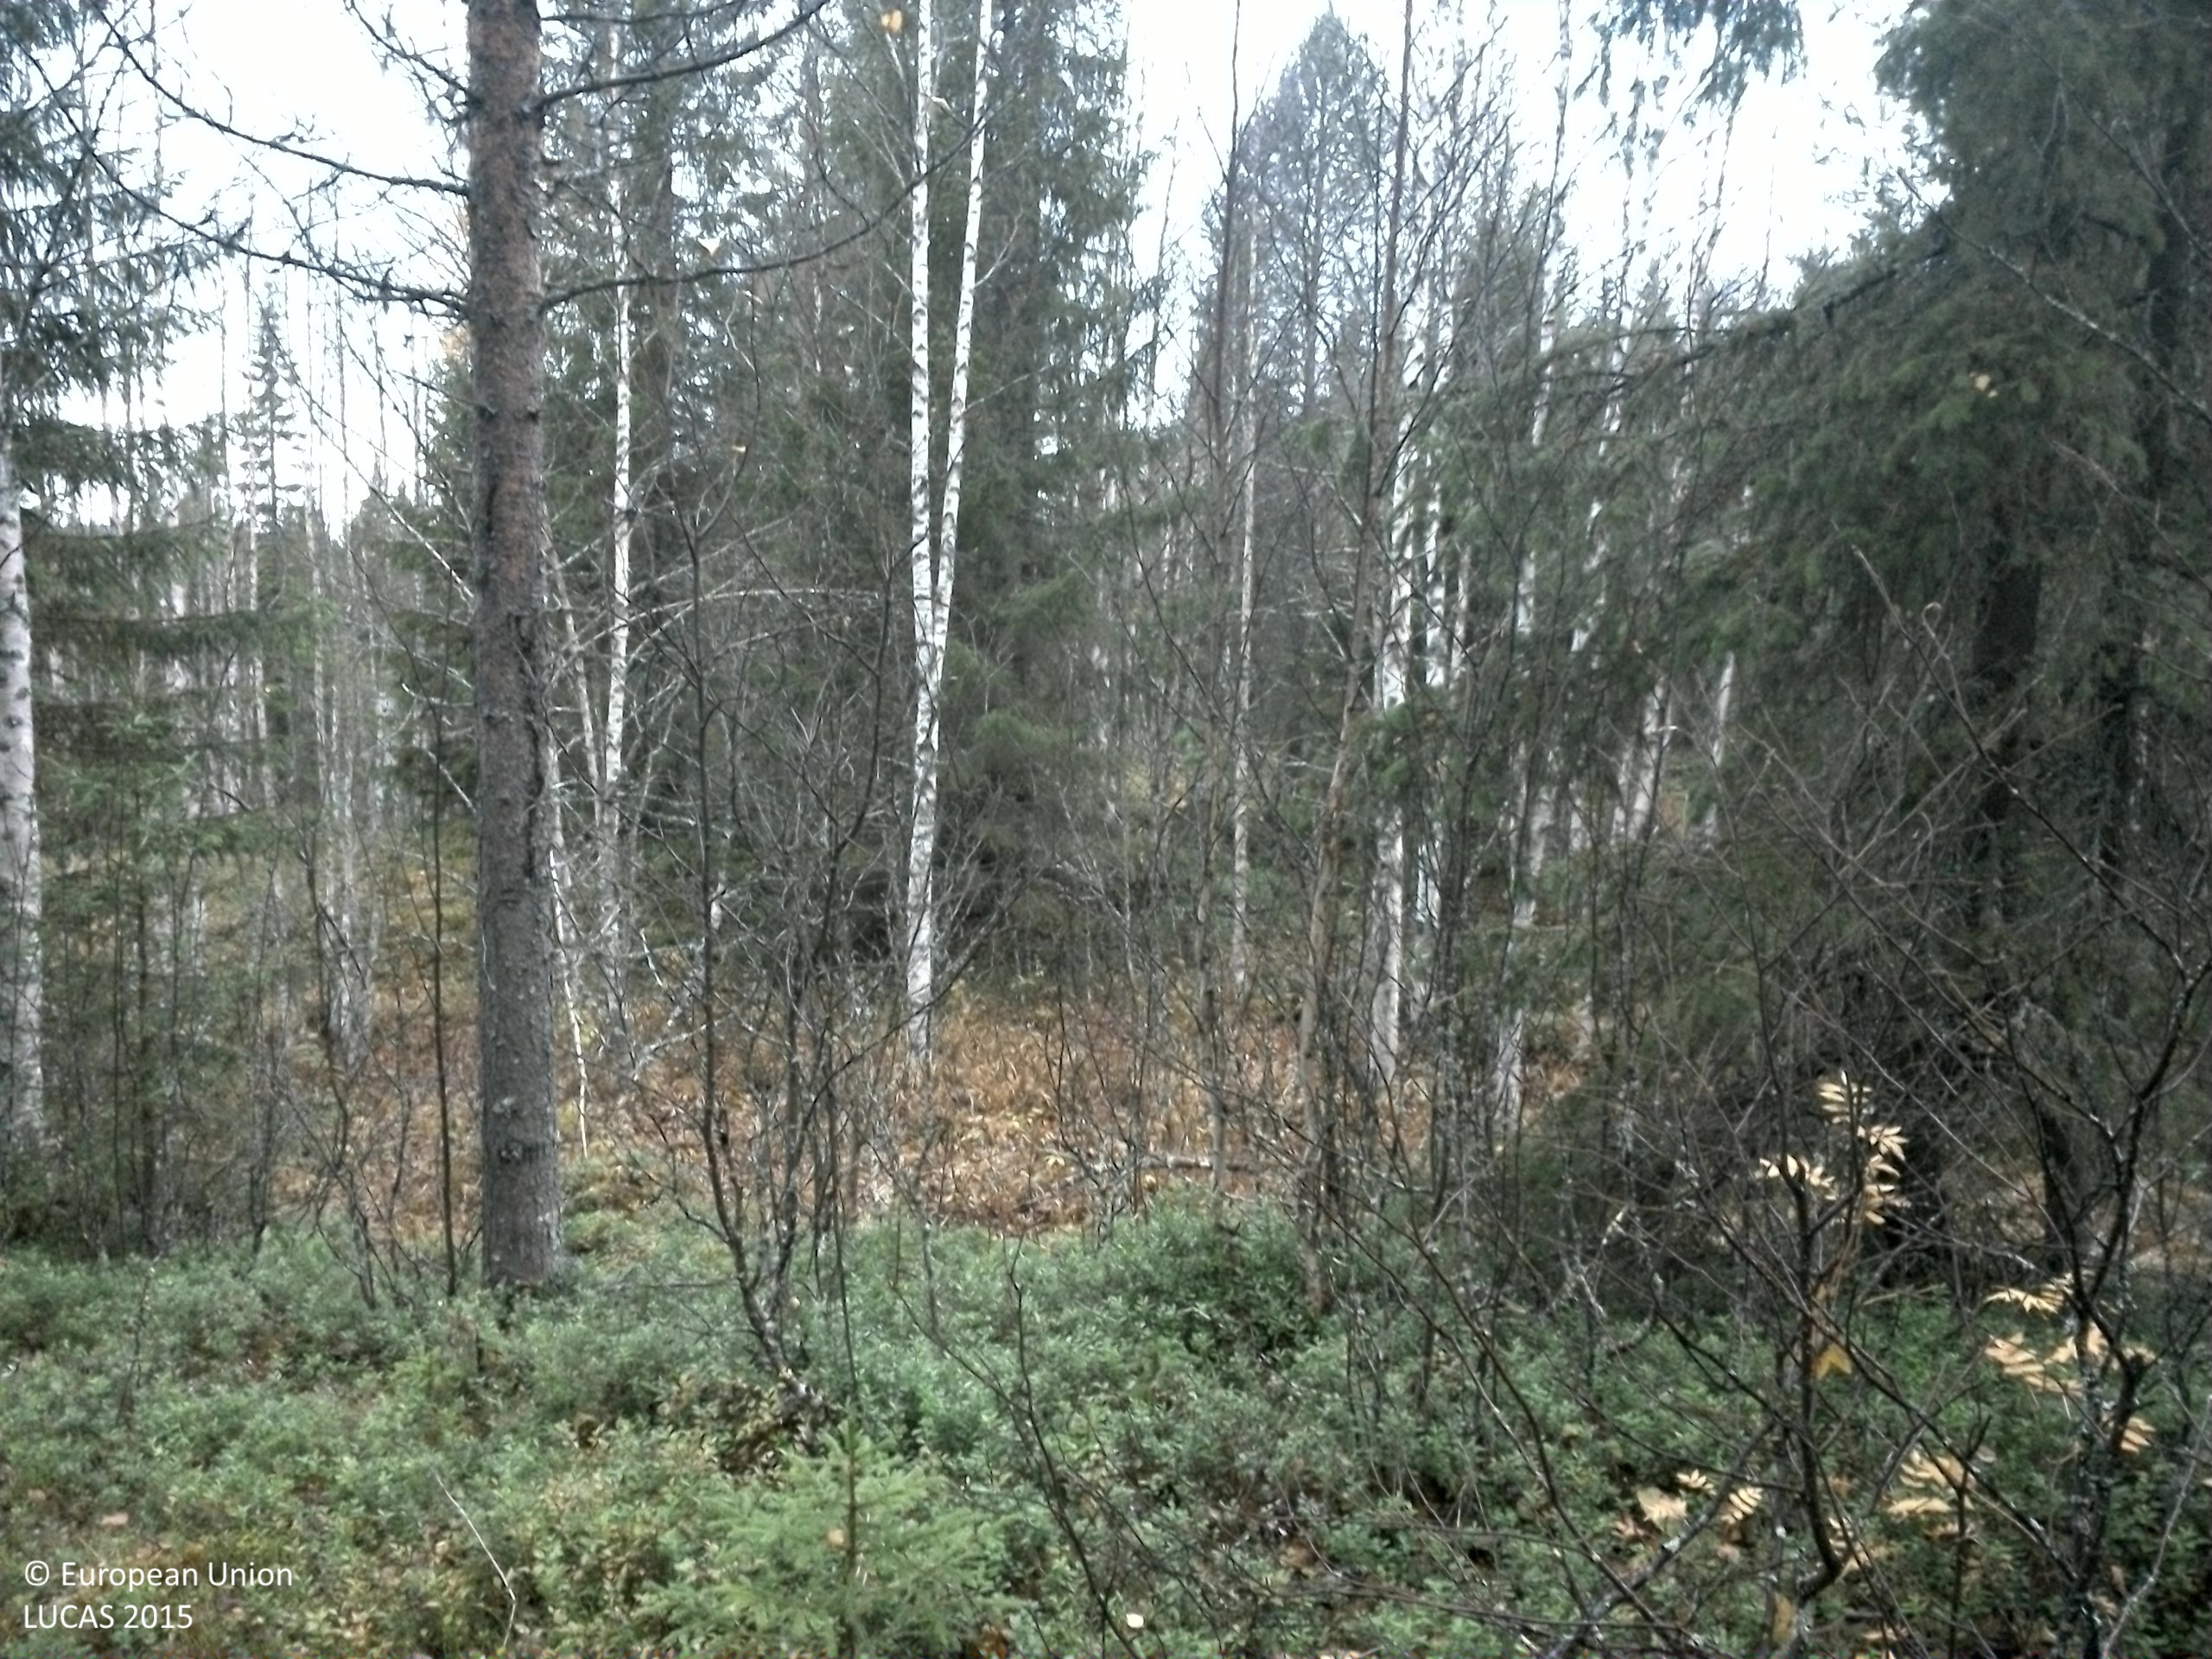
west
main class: Woodland
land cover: Other mixed woodland
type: boreal forest
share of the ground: 50 - 75 %
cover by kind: coniferous forest trees 45 %, shrubs 30 %, broadleaved forest trees 15 %, lichens and mosses 10 %
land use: Forestry
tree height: > 5 m
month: October
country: SE
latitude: 64.3101
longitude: 15.2852
